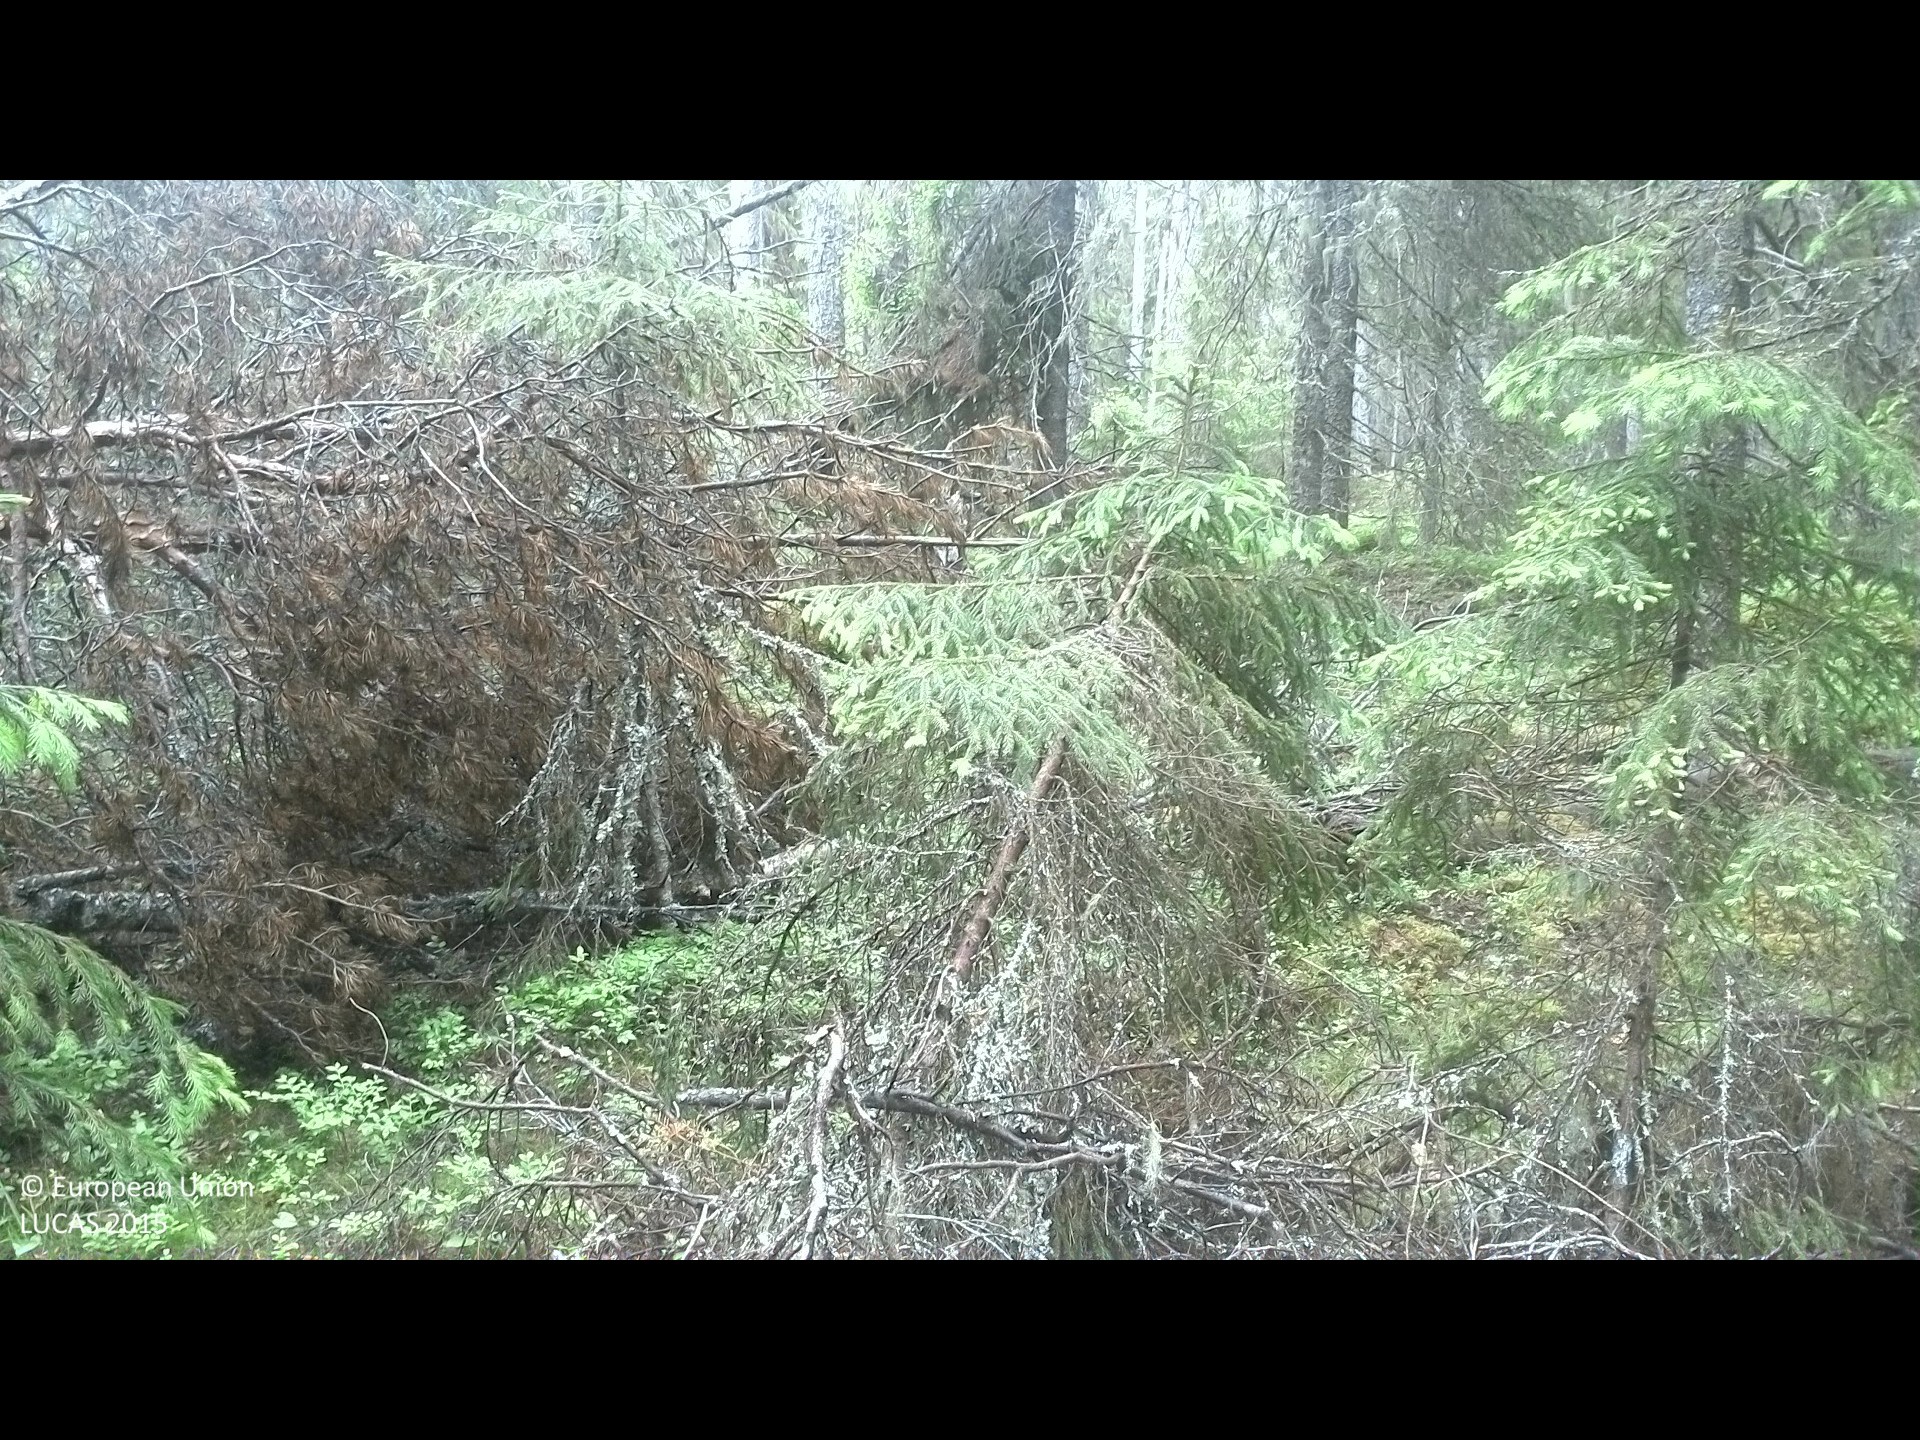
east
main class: Woodland
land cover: Spruce dominated coniferous woodland
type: boreal forest
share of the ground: 50 - 75 %
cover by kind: coniferous forest trees 50 %, shrubs 25 %, lichens and mosses 20 %, herbaceous plants 5 %
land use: Forestry
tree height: > 5 m
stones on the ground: 25 - 50 %
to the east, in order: Spruce dominated coniferous woodland; Spruce dominated mixed woodland; Spruce dominated coniferous woodland
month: June
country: SE
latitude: 62.0565
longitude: 16.8874
